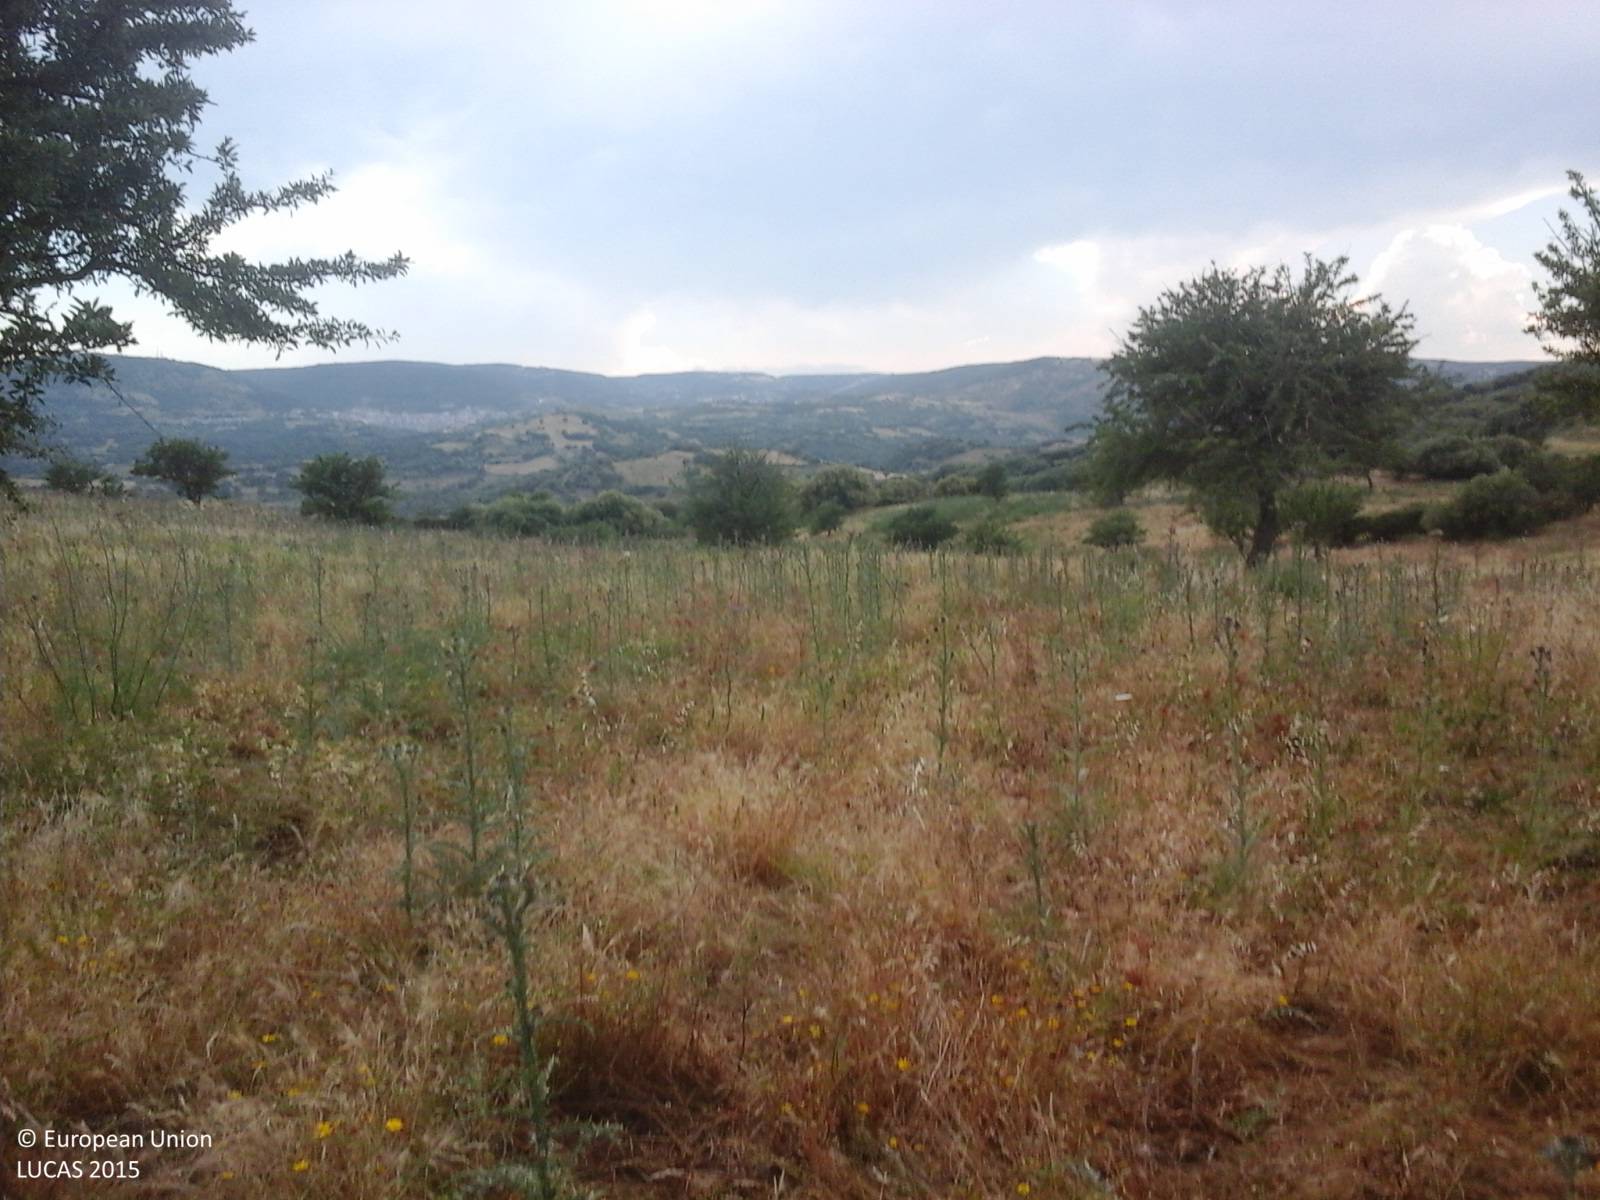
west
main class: Grassland
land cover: Grassland with sparse tree/shrub cover
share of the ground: > 75 %
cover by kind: herbaceous plants 95 %, broadleaved forest trees 5 %
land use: Agriculture (excluding fallow land and kitchen gardens)
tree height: > 5 m
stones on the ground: < 10 %
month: June
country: IT
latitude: 40.5010
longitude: 9.4247
